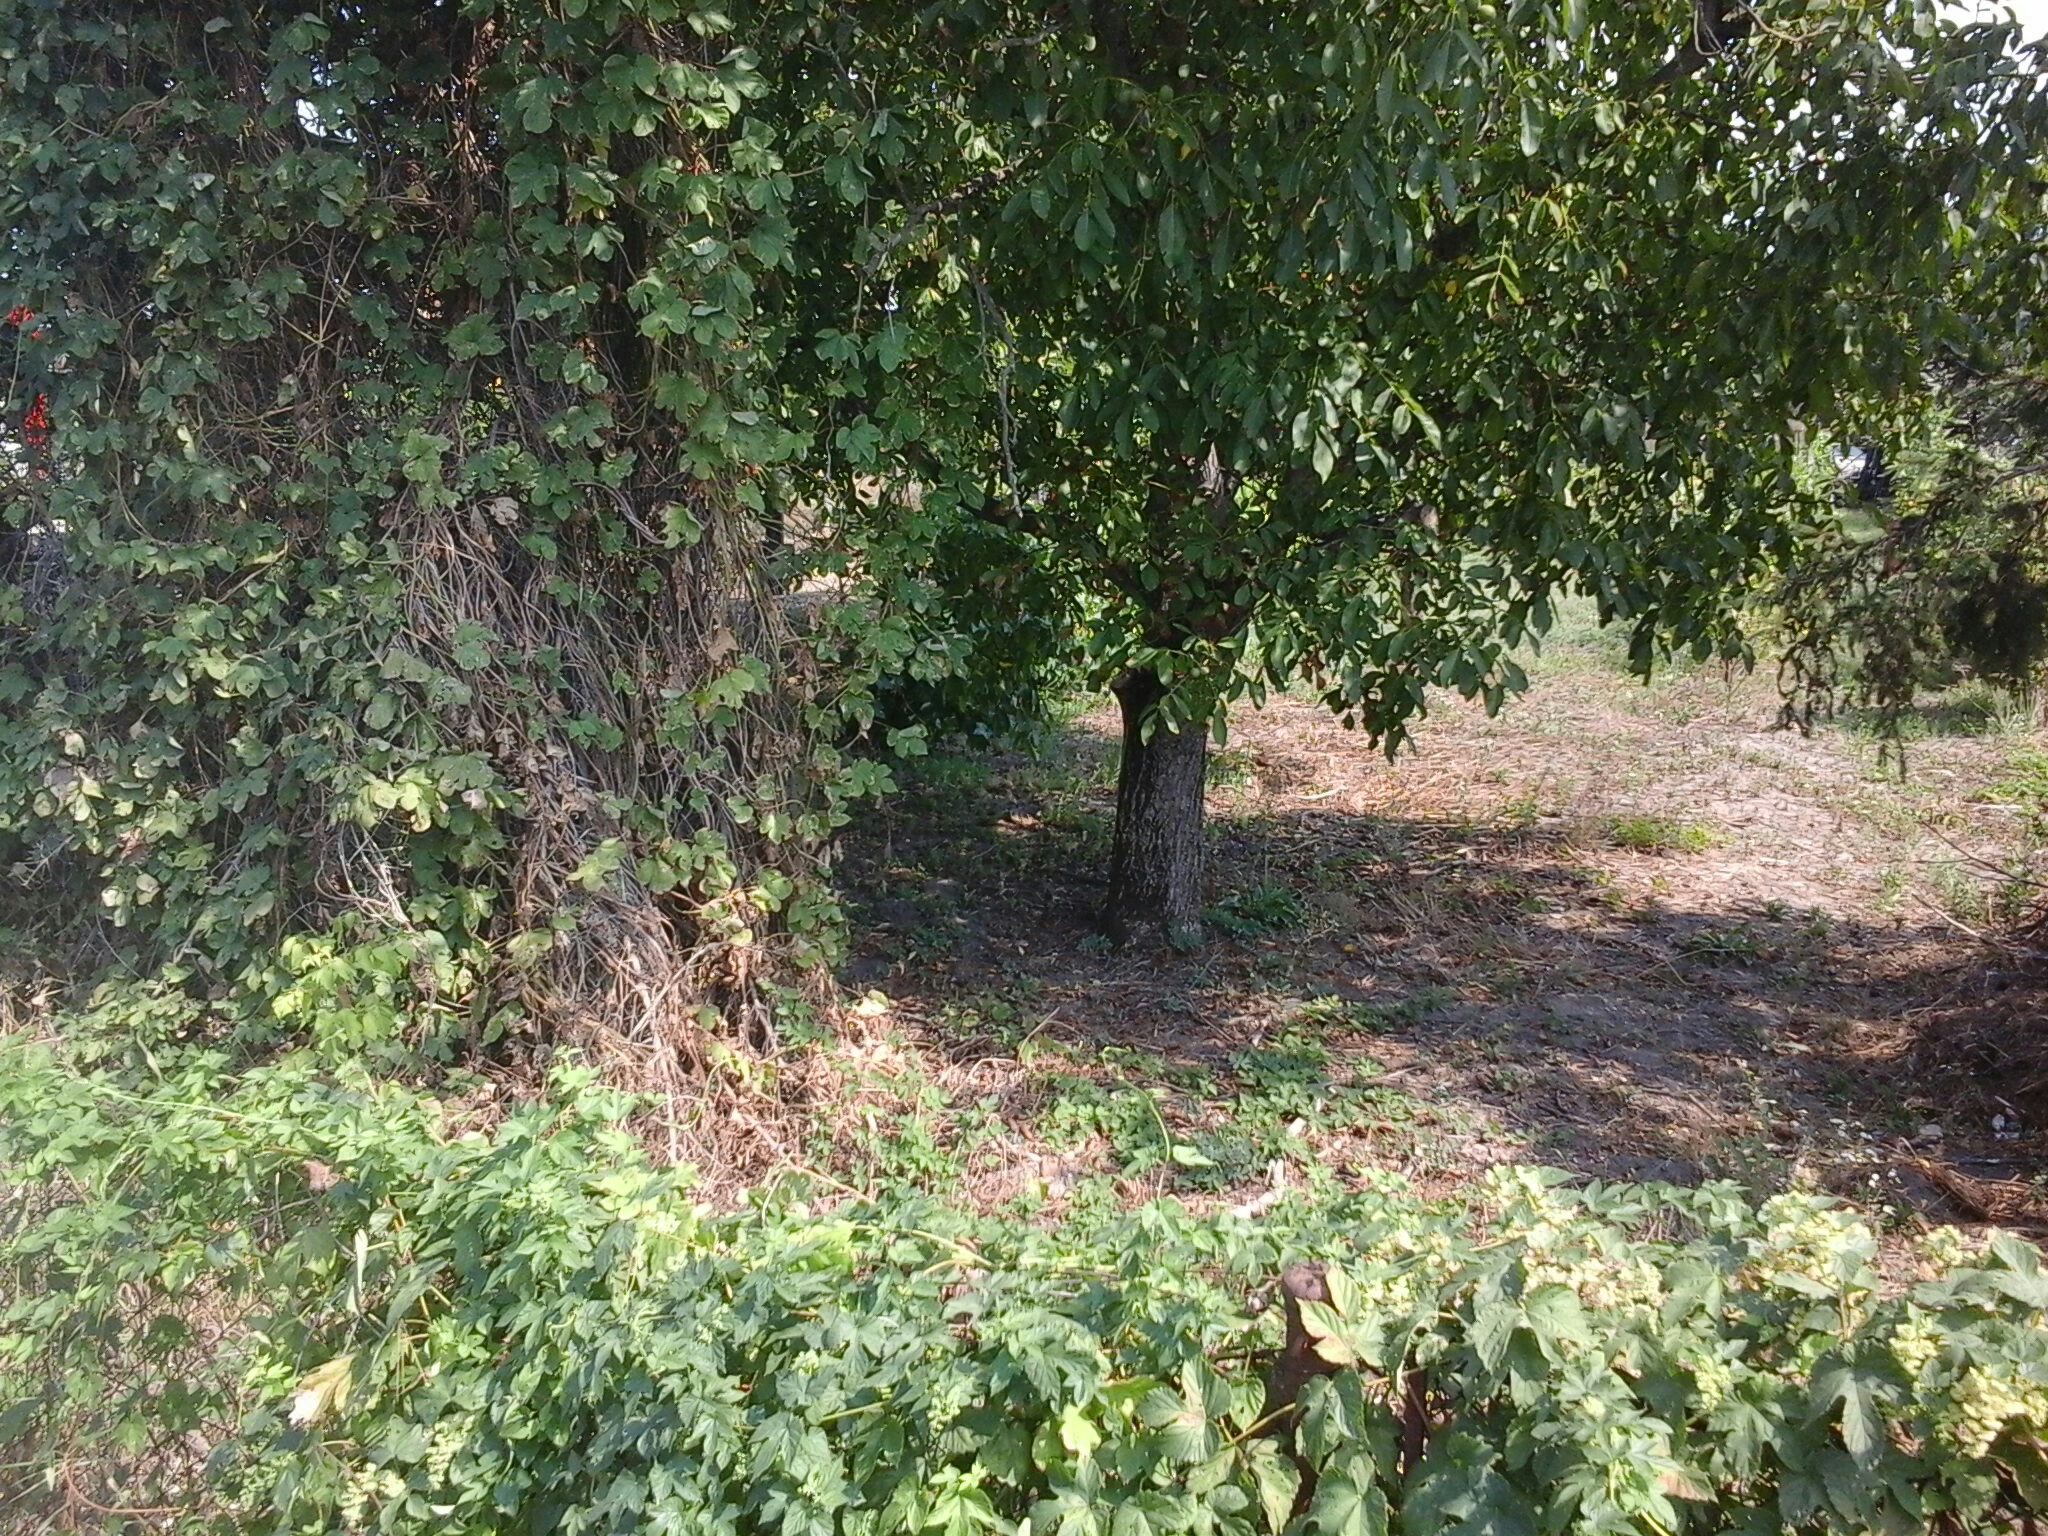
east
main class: Cropland
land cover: Vineyards
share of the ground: 10 - 25 %
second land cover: Grassland without tree/shrub cover
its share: 50 - 75 %
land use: Kitchen garden
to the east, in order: Vineyards; Grassland without tree/shrub cover; Artificial constructions in urban areas
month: August
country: HU
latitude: 48.0834
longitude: 19.2980
